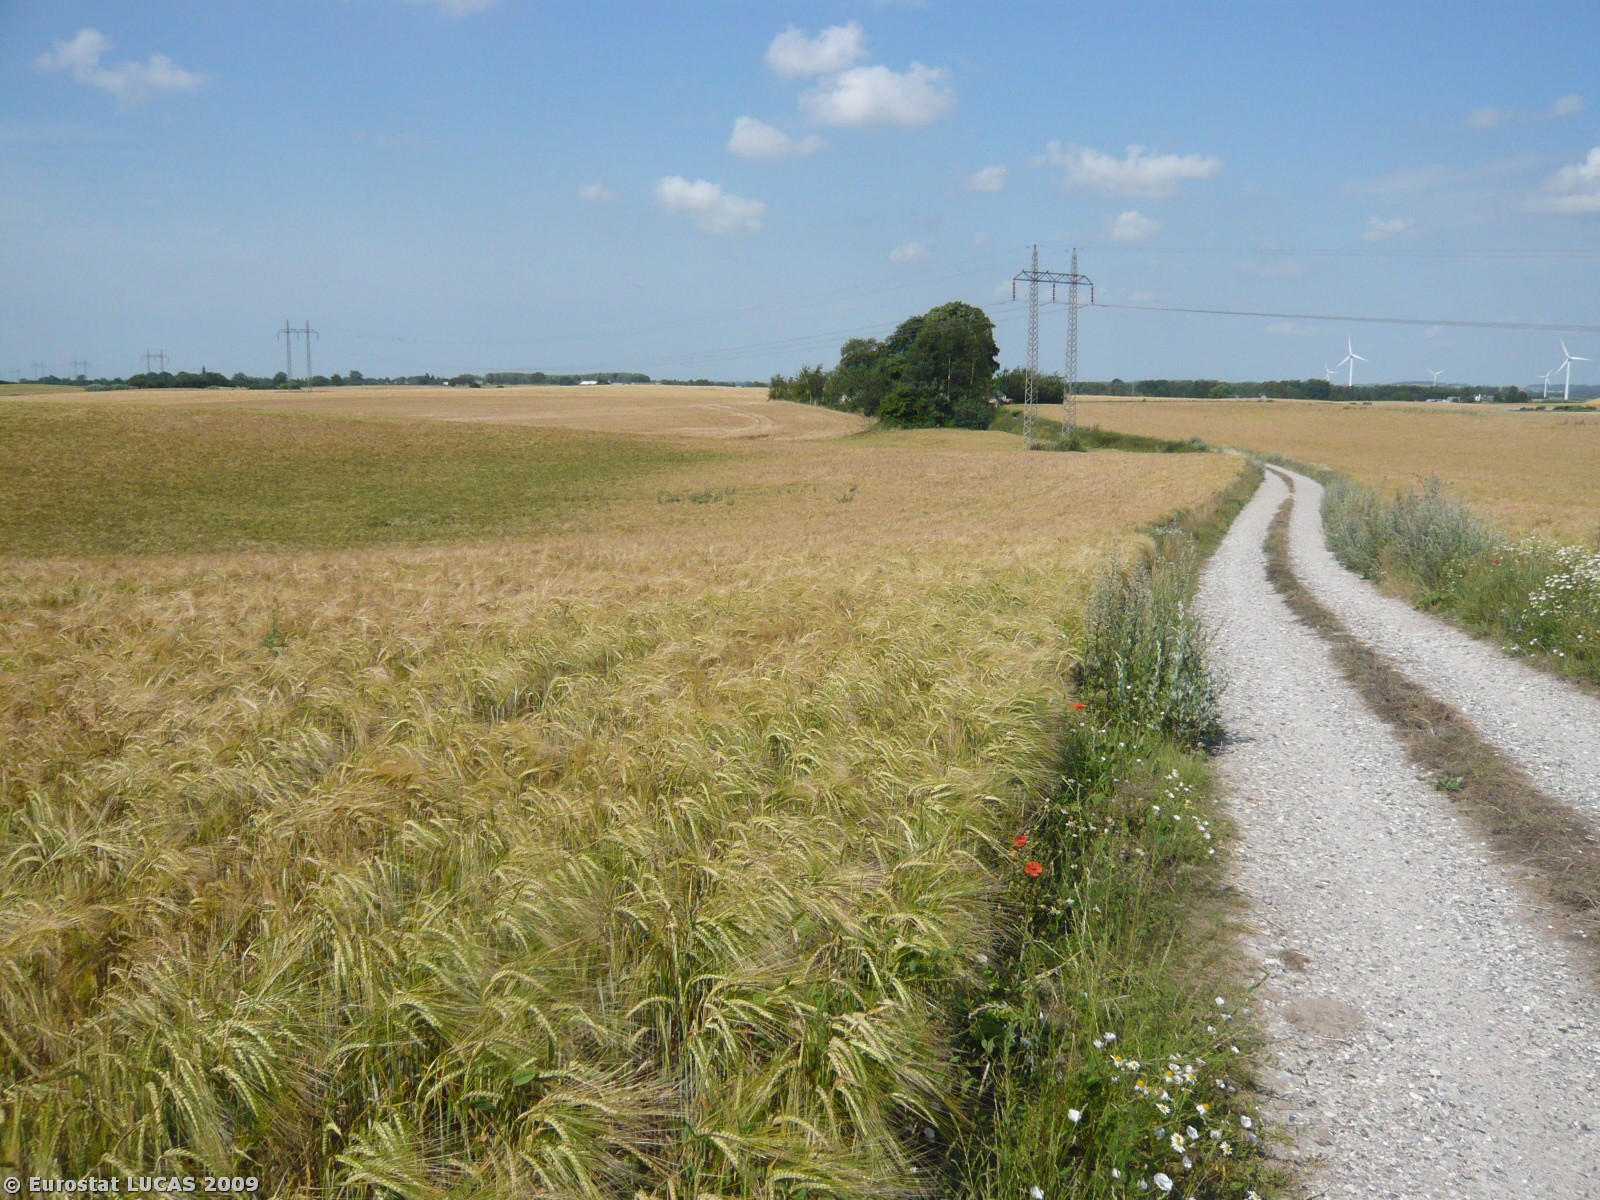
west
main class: Cropland
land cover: Barley
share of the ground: > 75 %
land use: Agriculture (excluding fallow land and kitchen gardens)
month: July
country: DK
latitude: 55.5815
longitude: 11.8227
